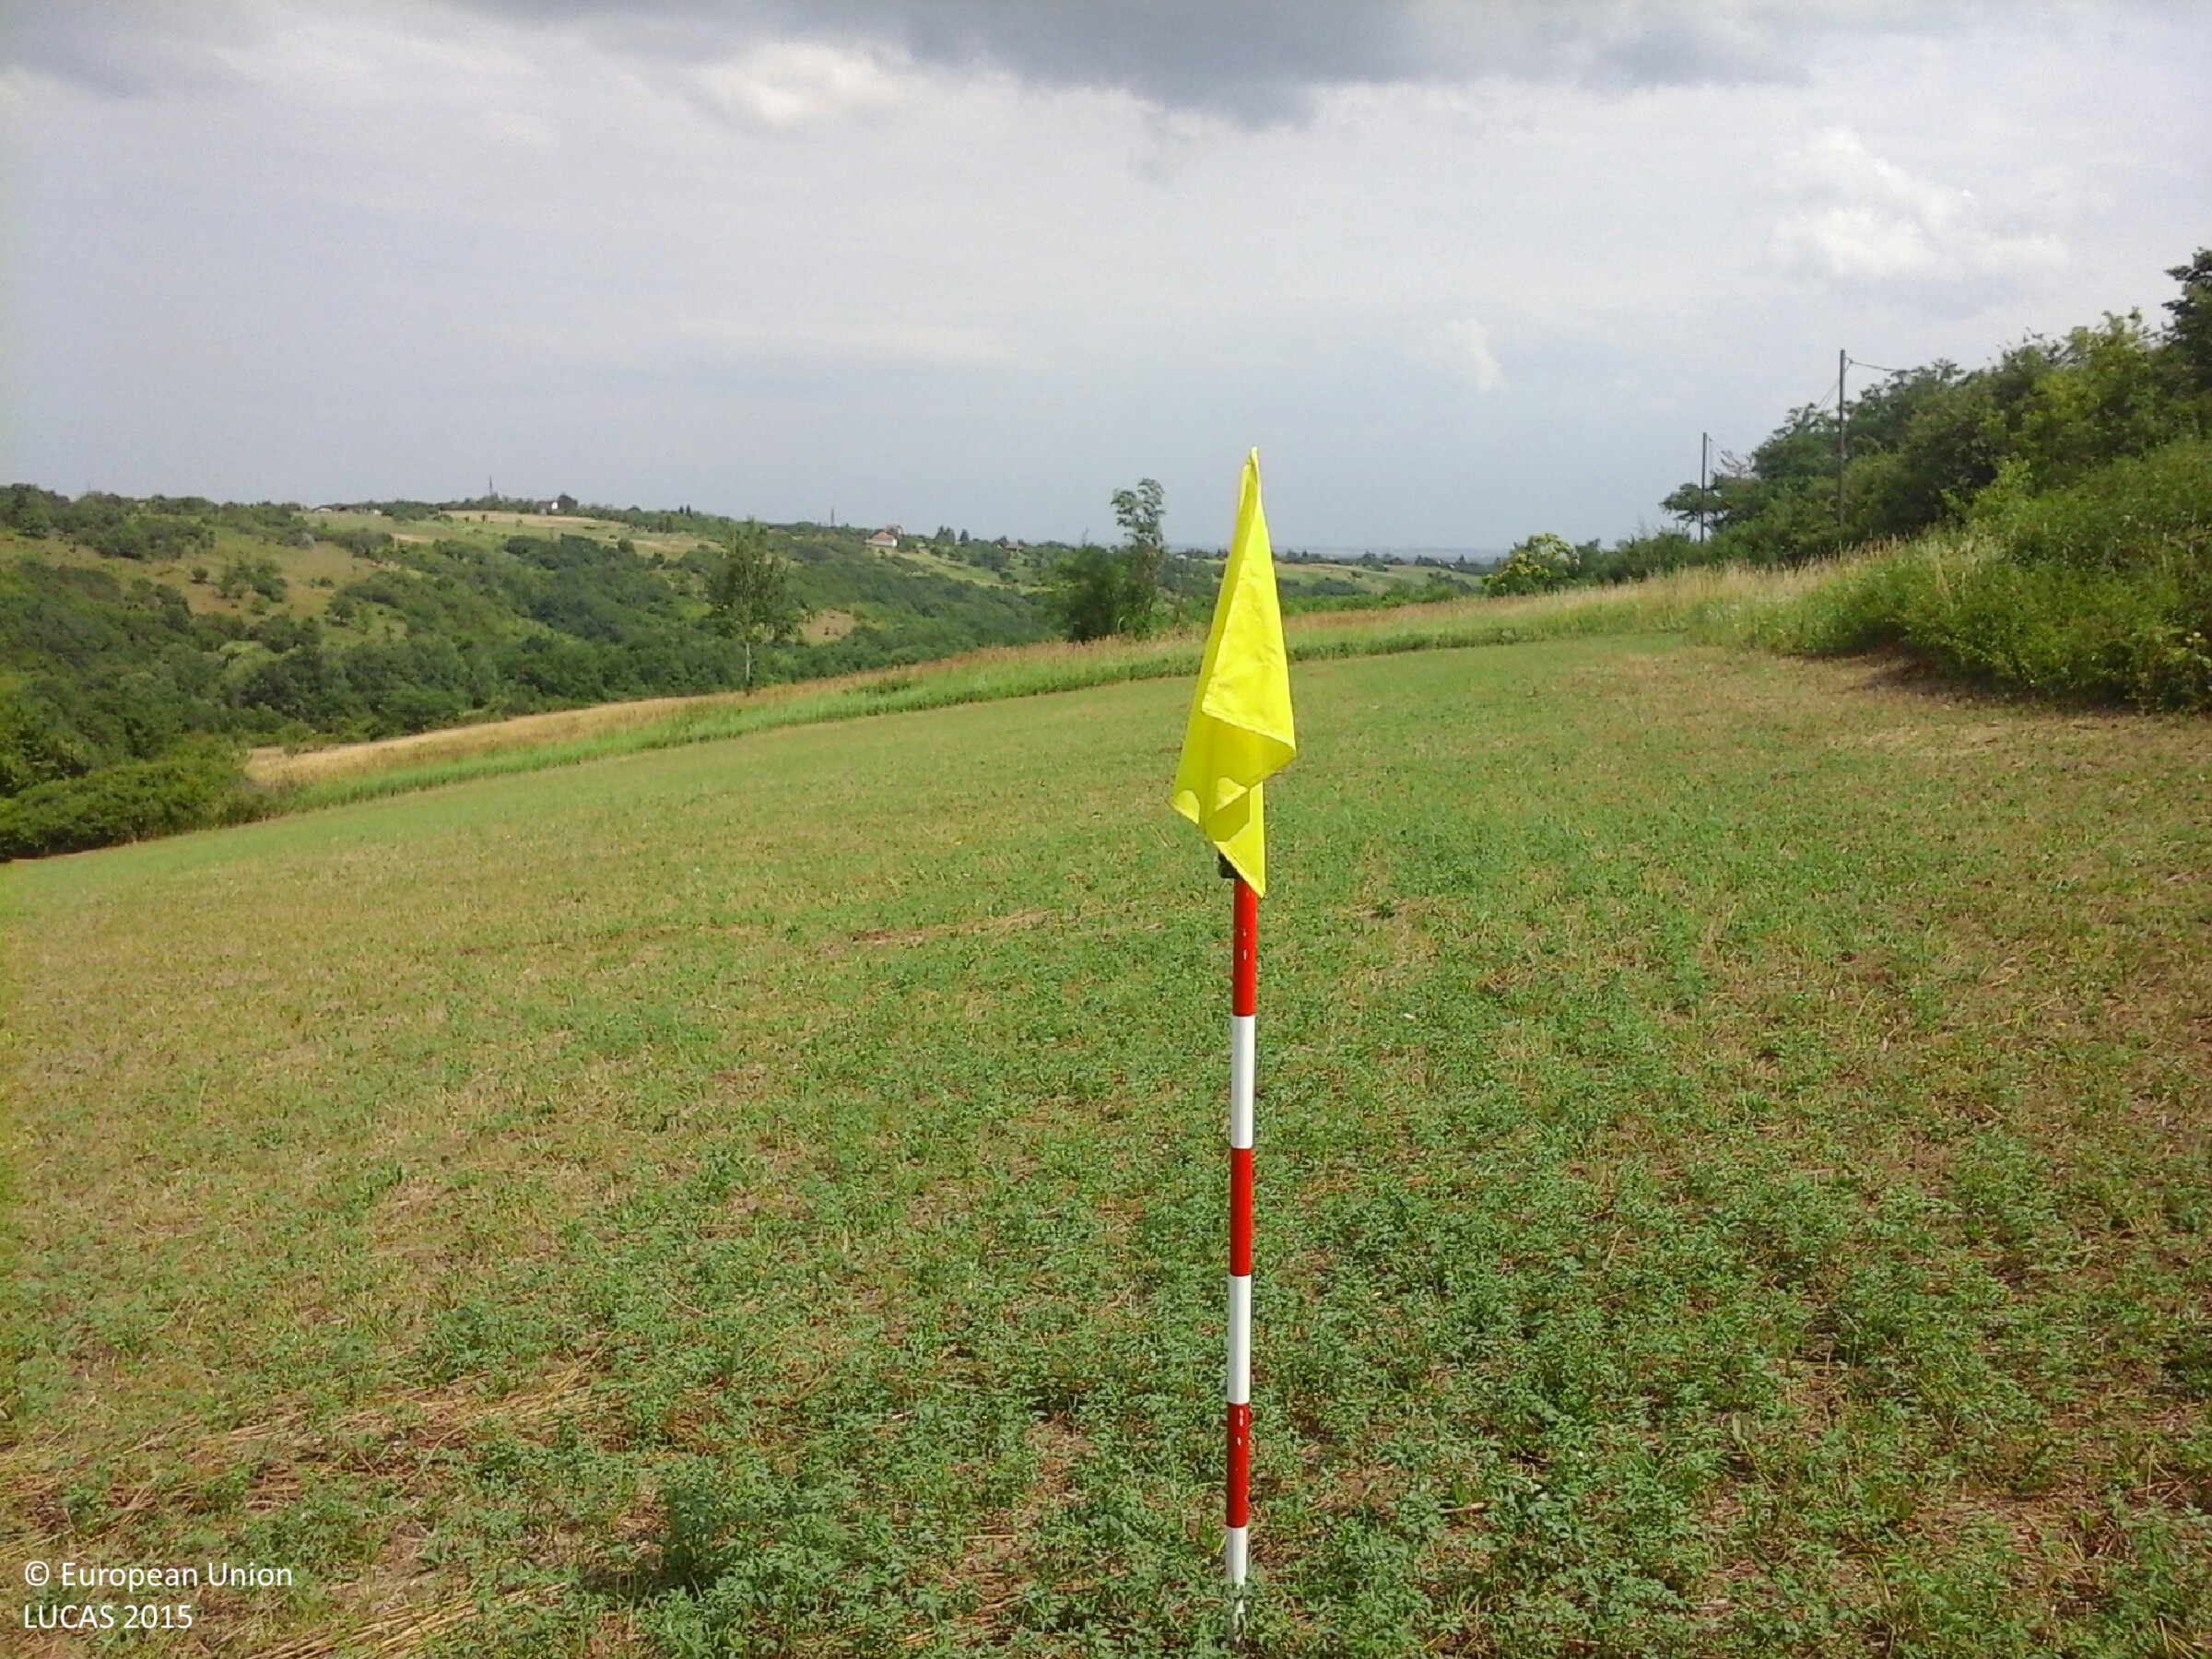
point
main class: Cropland
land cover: Lucerne
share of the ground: > 75 %
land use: Agriculture (excluding fallow land and kitchen gardens)
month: July
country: HU
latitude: 48.1324
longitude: 20.7456
